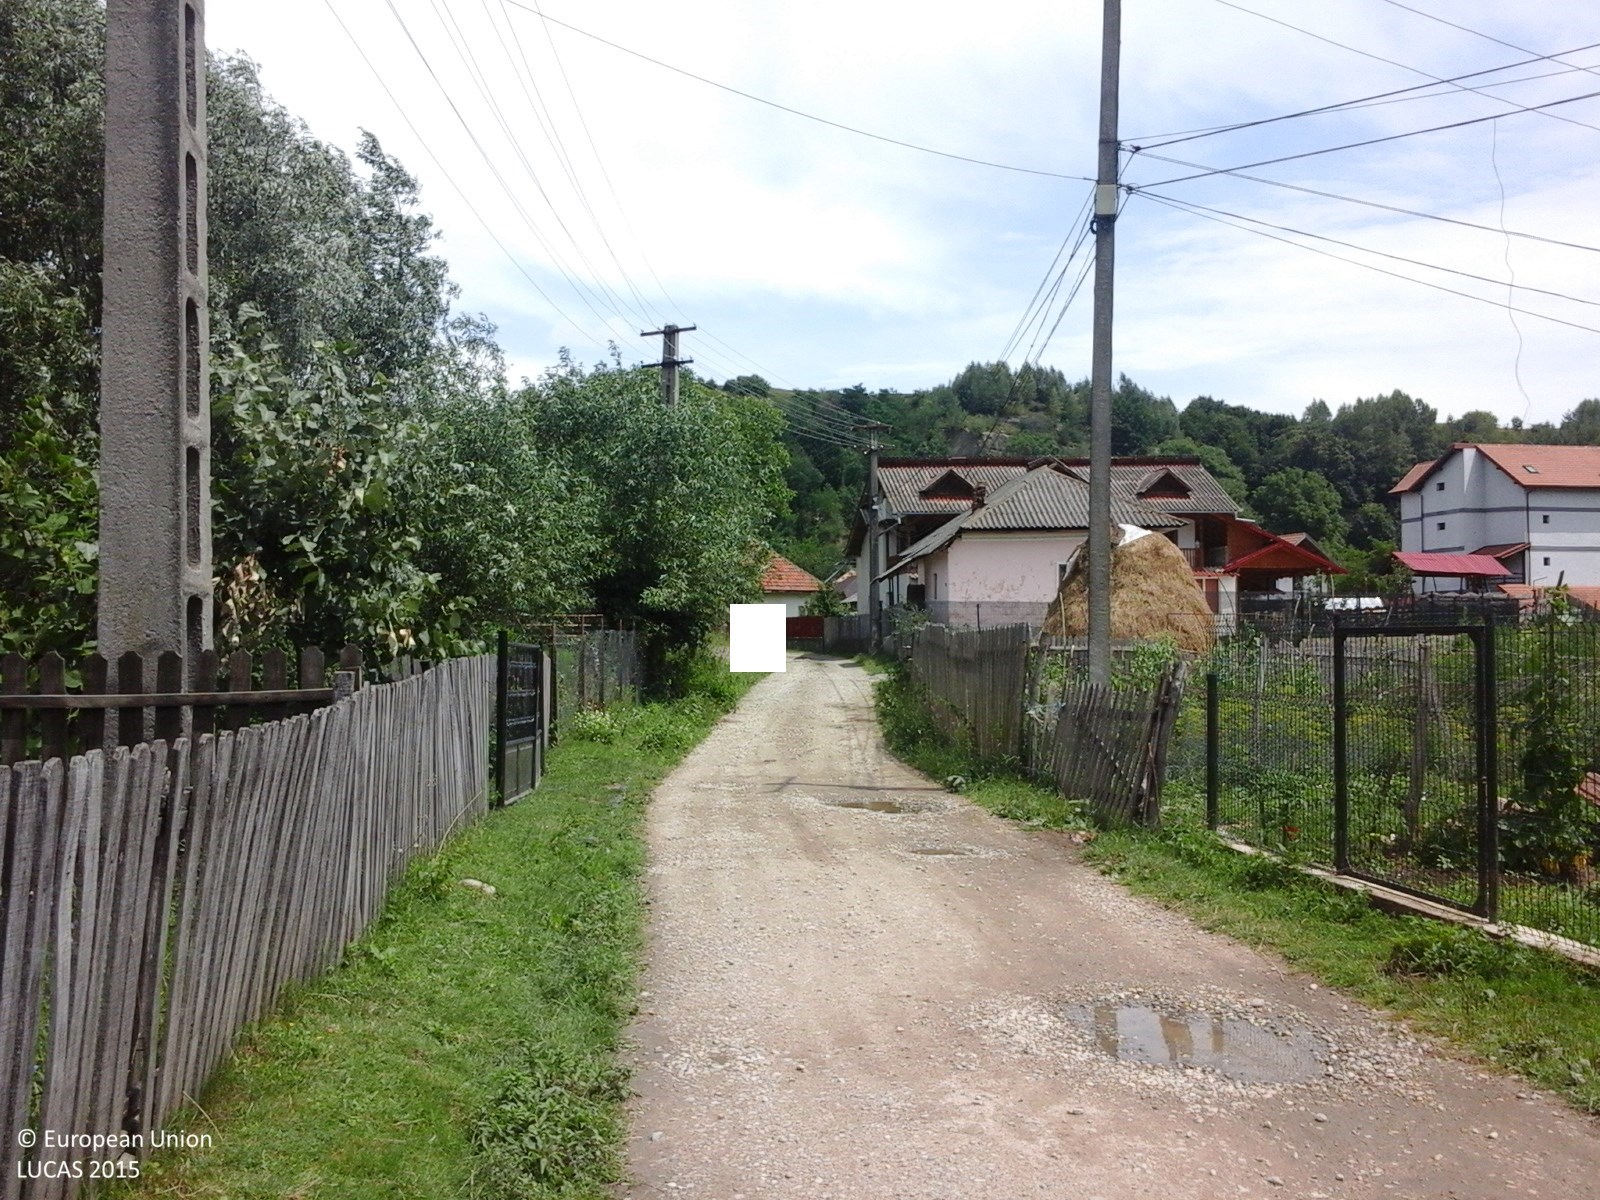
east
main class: Cropland
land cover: Potatoes
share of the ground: > 75 %
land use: Kitchen garden
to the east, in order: Potatoes; Sugar beet; Tomatoes; Fences; Grassland without tree/shrub cover; Fences; Spontaneously vegetated surfaces; Fences; Other fruit trees and berries; Electric lines; Other fruit trees and berries; Artificial constructions in urban areas; Broadleaved woodland
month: July
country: RO
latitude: 45.2769
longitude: 24.8072
